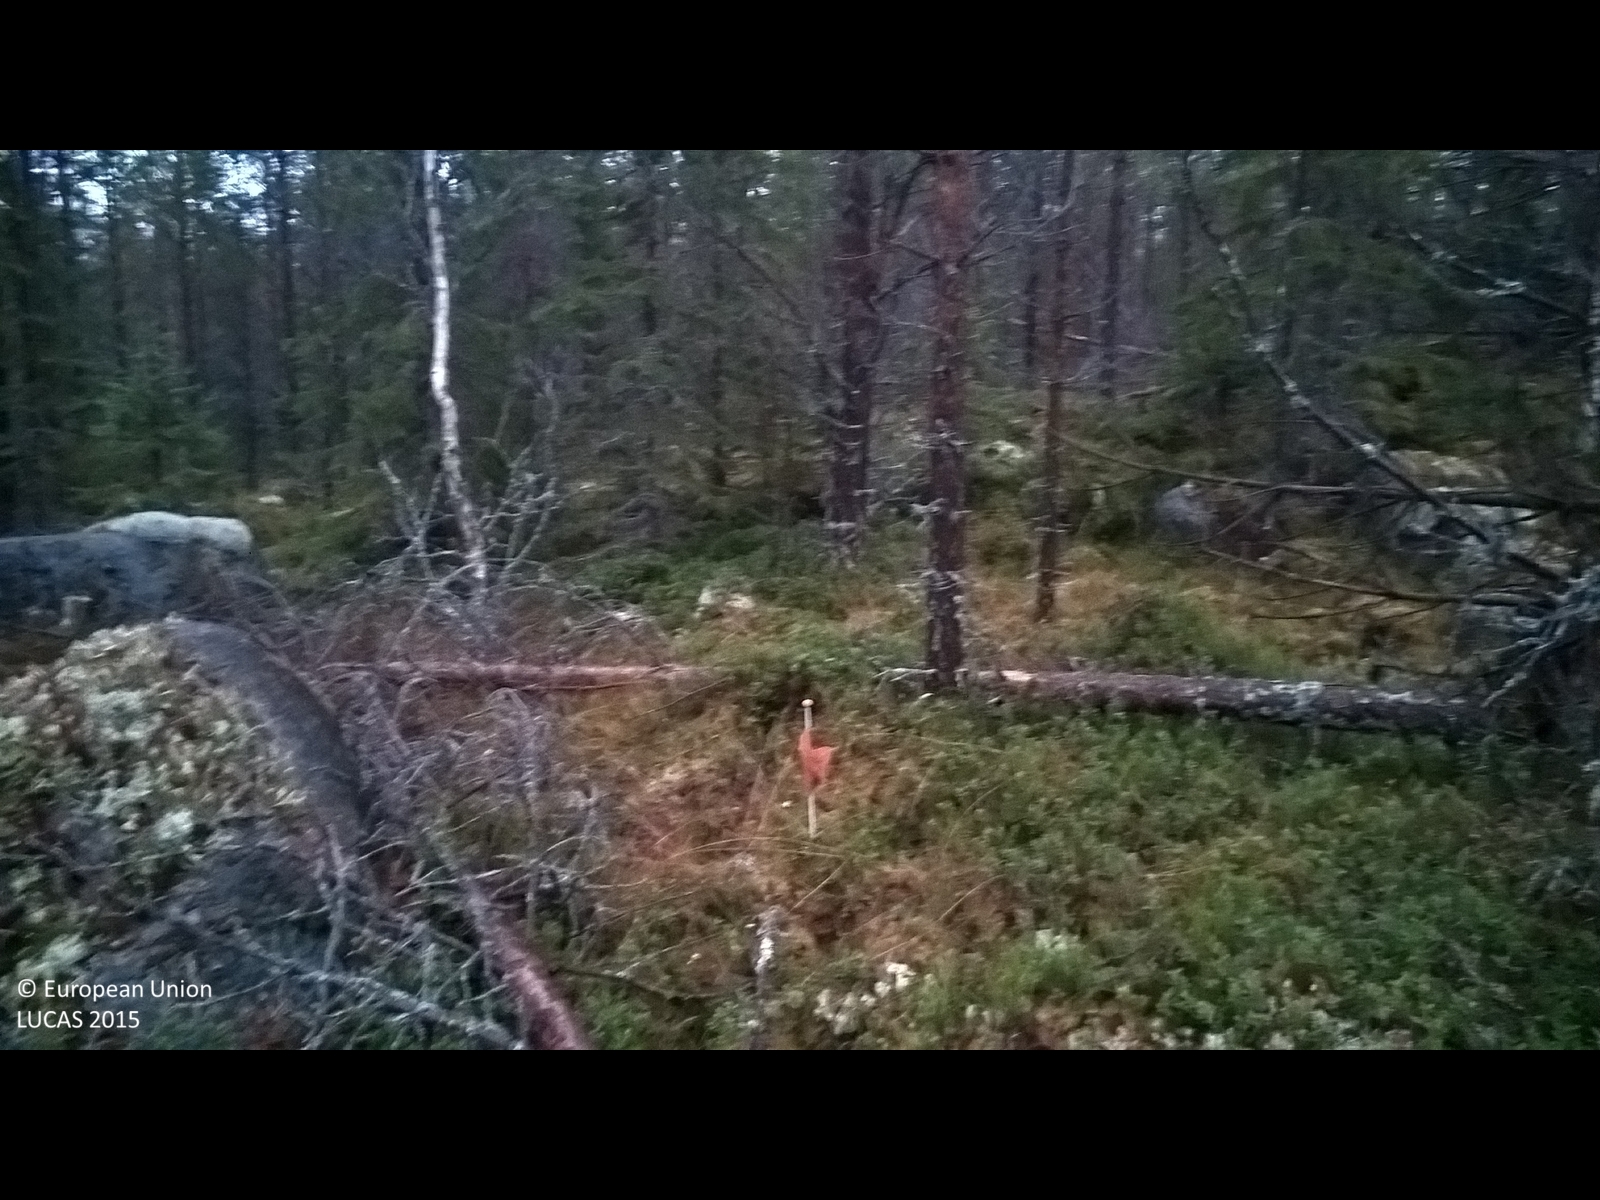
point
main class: Woodland
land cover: Pine dominated coniferous woodland
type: boreal forest
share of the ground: > 75 %
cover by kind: coniferous forest trees 70 %, broadleaved forest trees 10 %, shrubs 10 %, lichens and mosses 10 %
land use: Forestry
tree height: > 5 m
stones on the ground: < 10 %
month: November
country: SE
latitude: 61.9668
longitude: 15.0750
